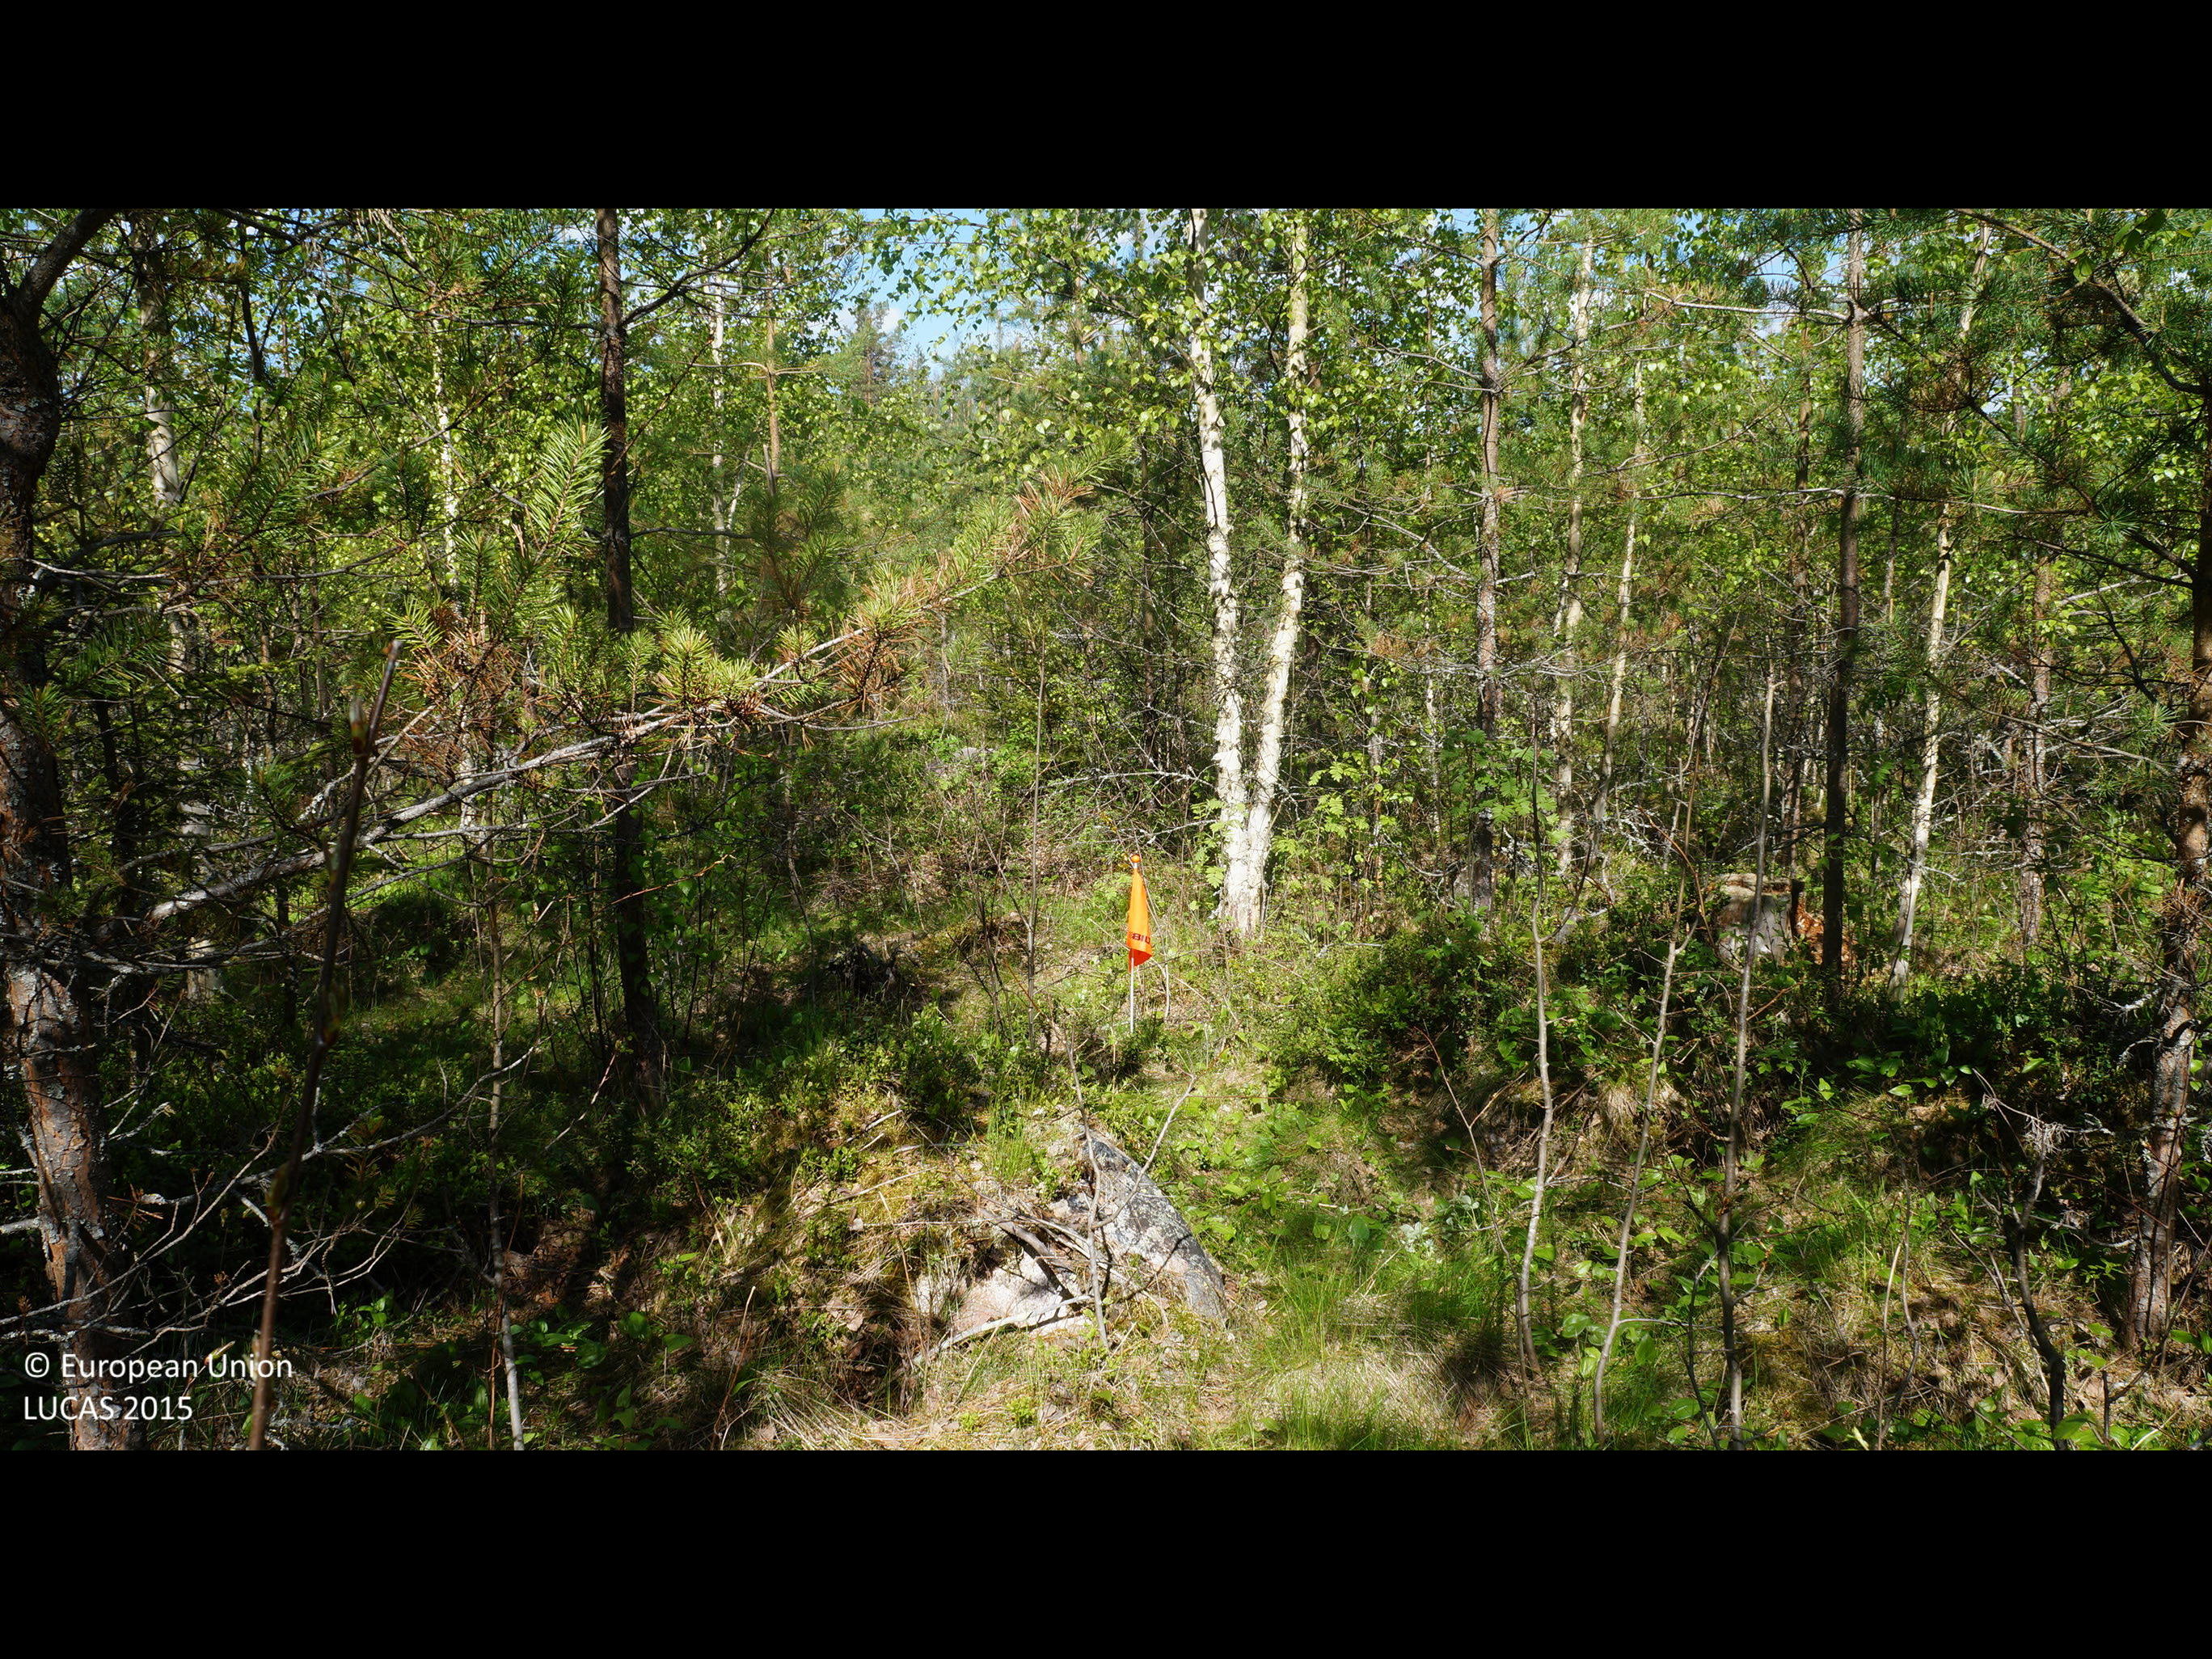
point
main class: Woodland
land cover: Other mixed woodland
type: boreal forest
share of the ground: > 75 %
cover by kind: coniferous forest trees 60 %, broadleaved forest trees 20 %, shrubs 20 %
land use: Forestry
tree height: > 5 m
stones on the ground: > 50 %
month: June
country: FI
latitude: 63.7413
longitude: 23.3264
